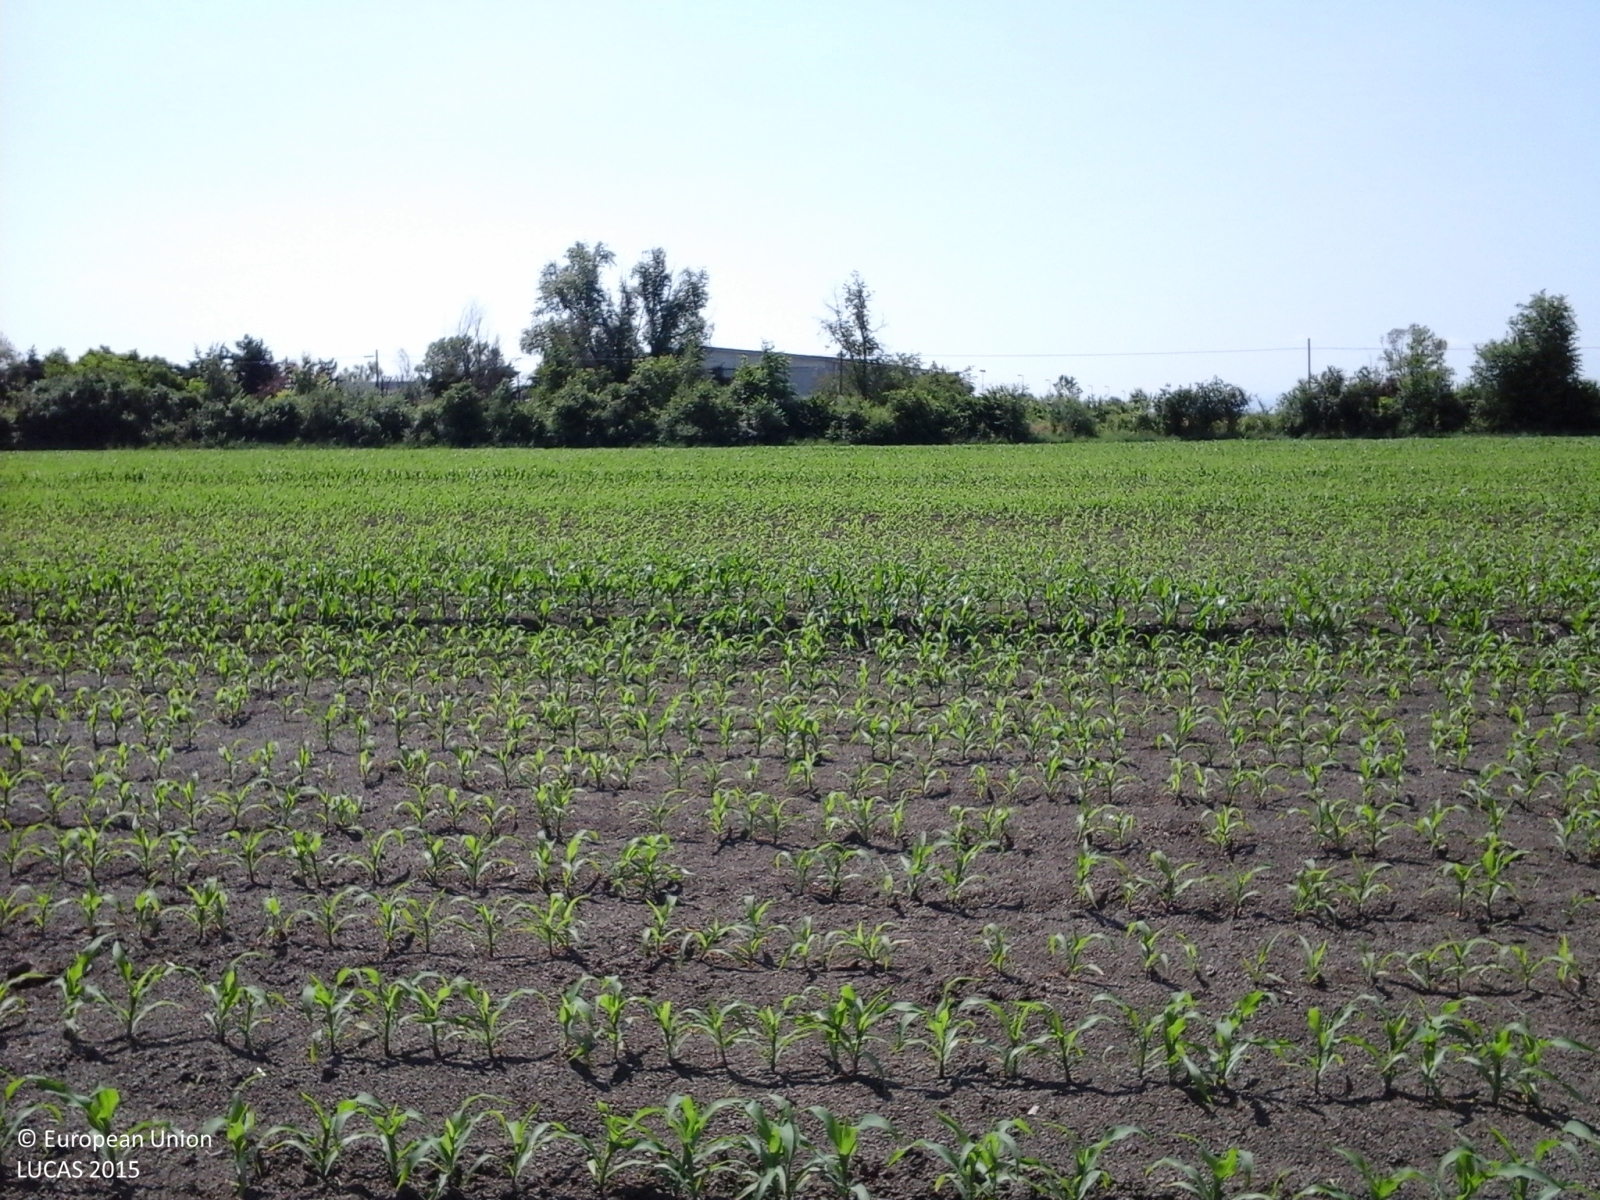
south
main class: Cropland
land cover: Maize
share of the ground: < 10 %
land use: Agriculture (excluding fallow land and kitchen gardens)
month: May
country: IT
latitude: 44.8717
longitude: 10.6190
